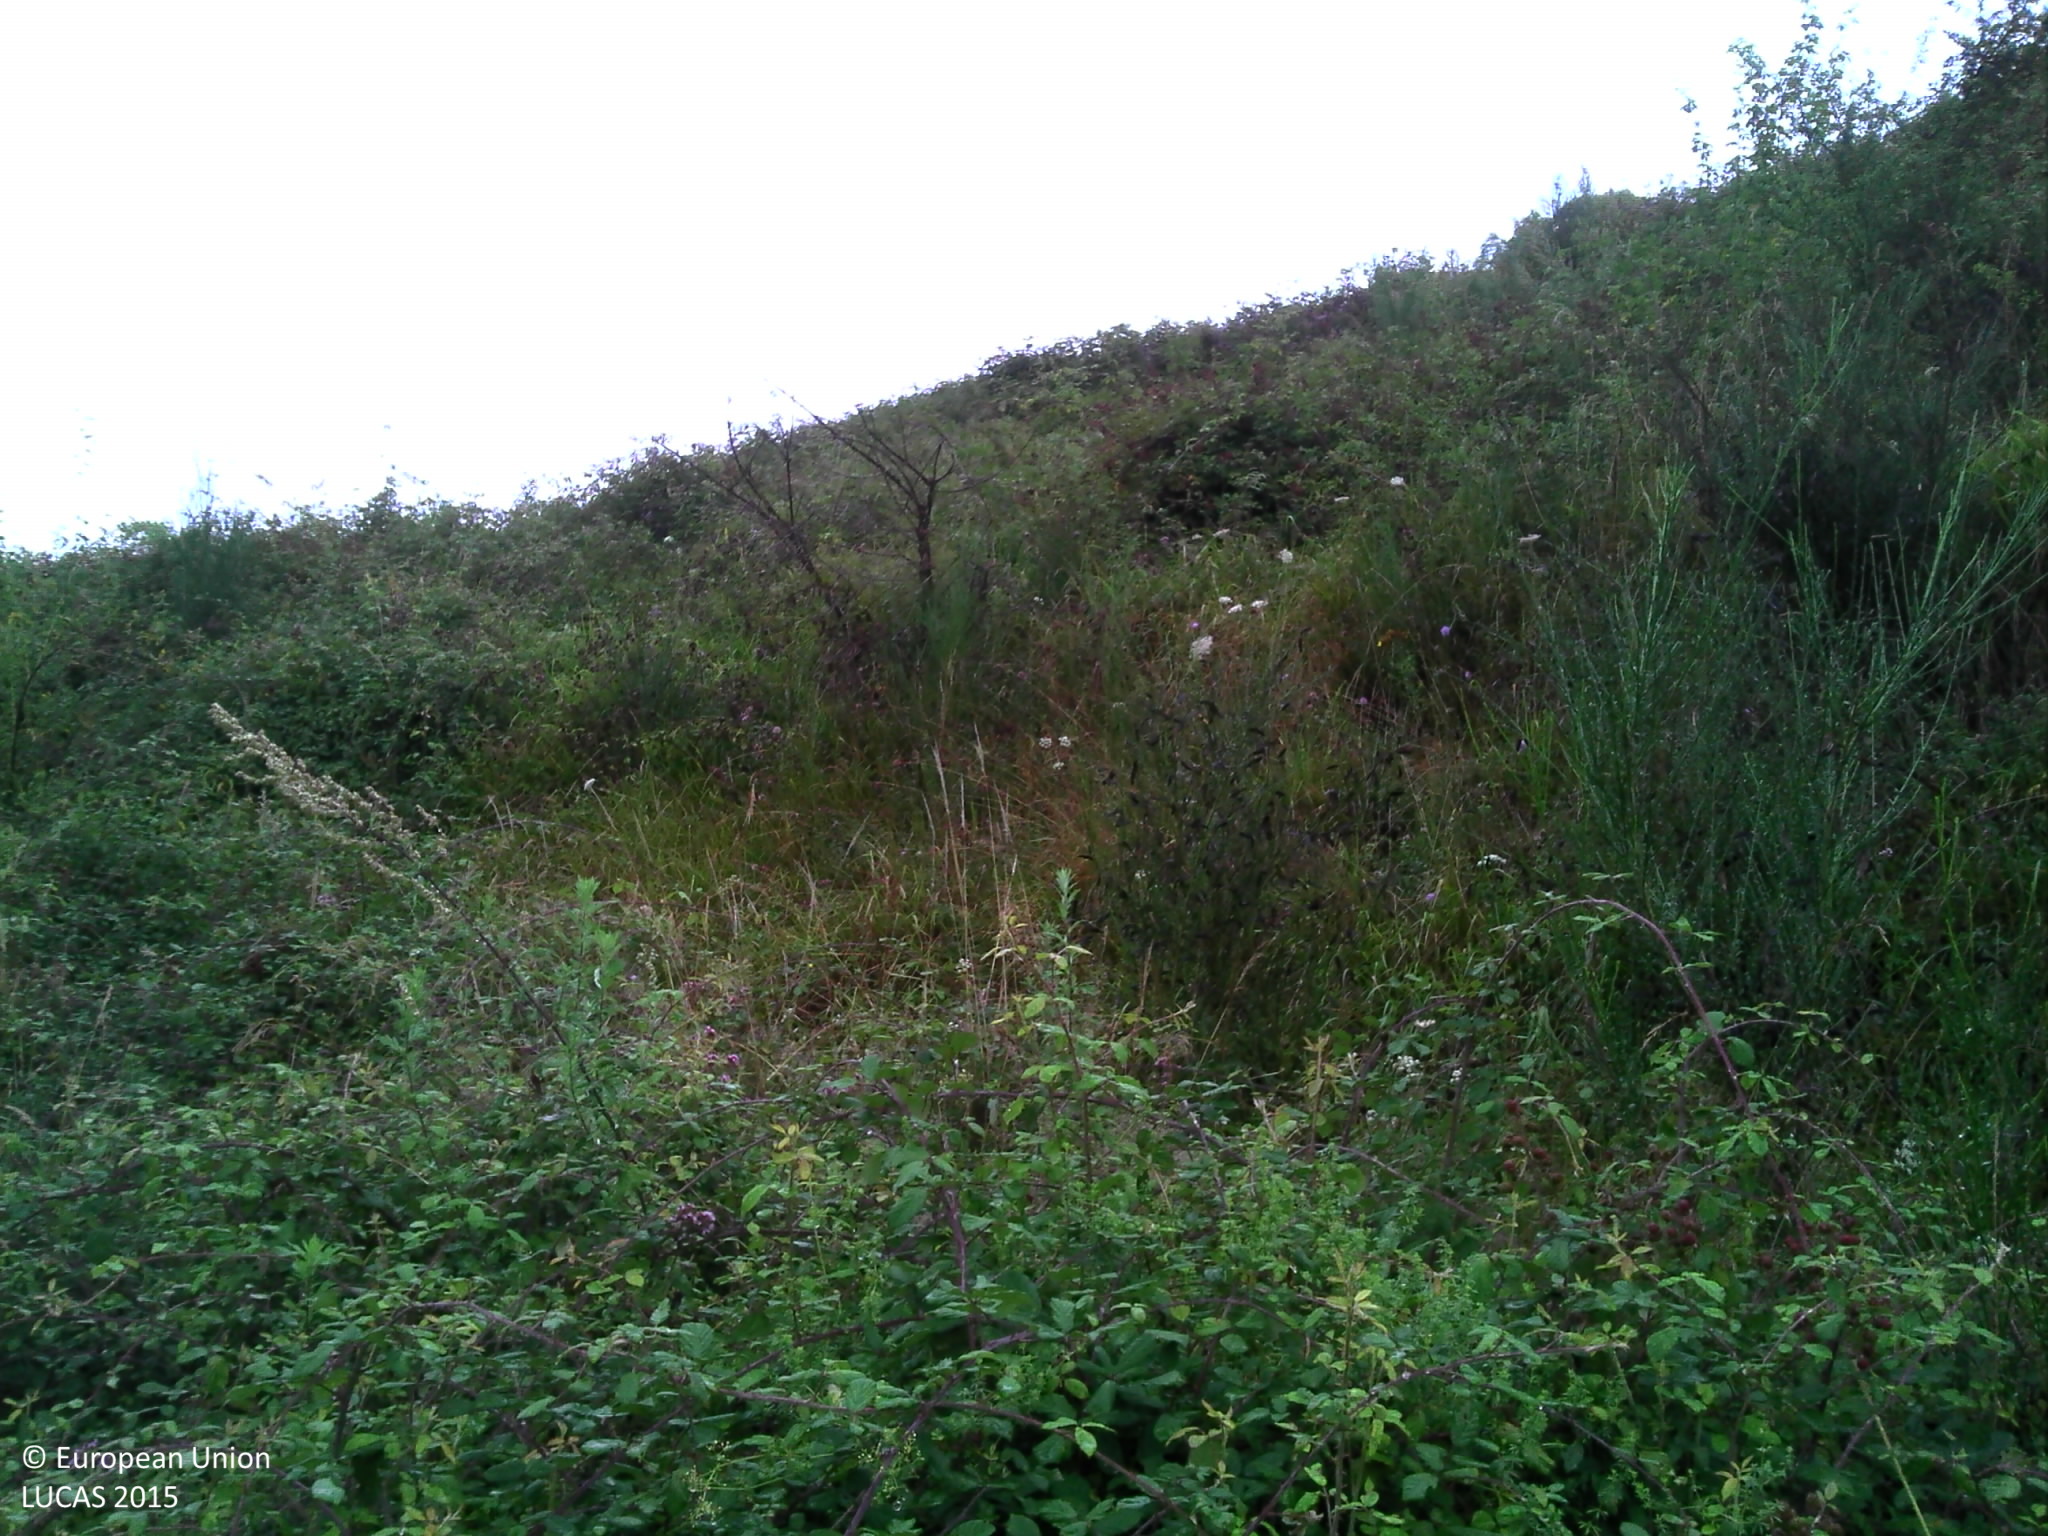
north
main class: Grassland
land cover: Spontaneously vegetated surfaces
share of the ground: > 75 %
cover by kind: herbaceous plants 100 %
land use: Semi-natural and natural areas not in use
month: August
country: FR
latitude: 42.8929
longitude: 1.0535
